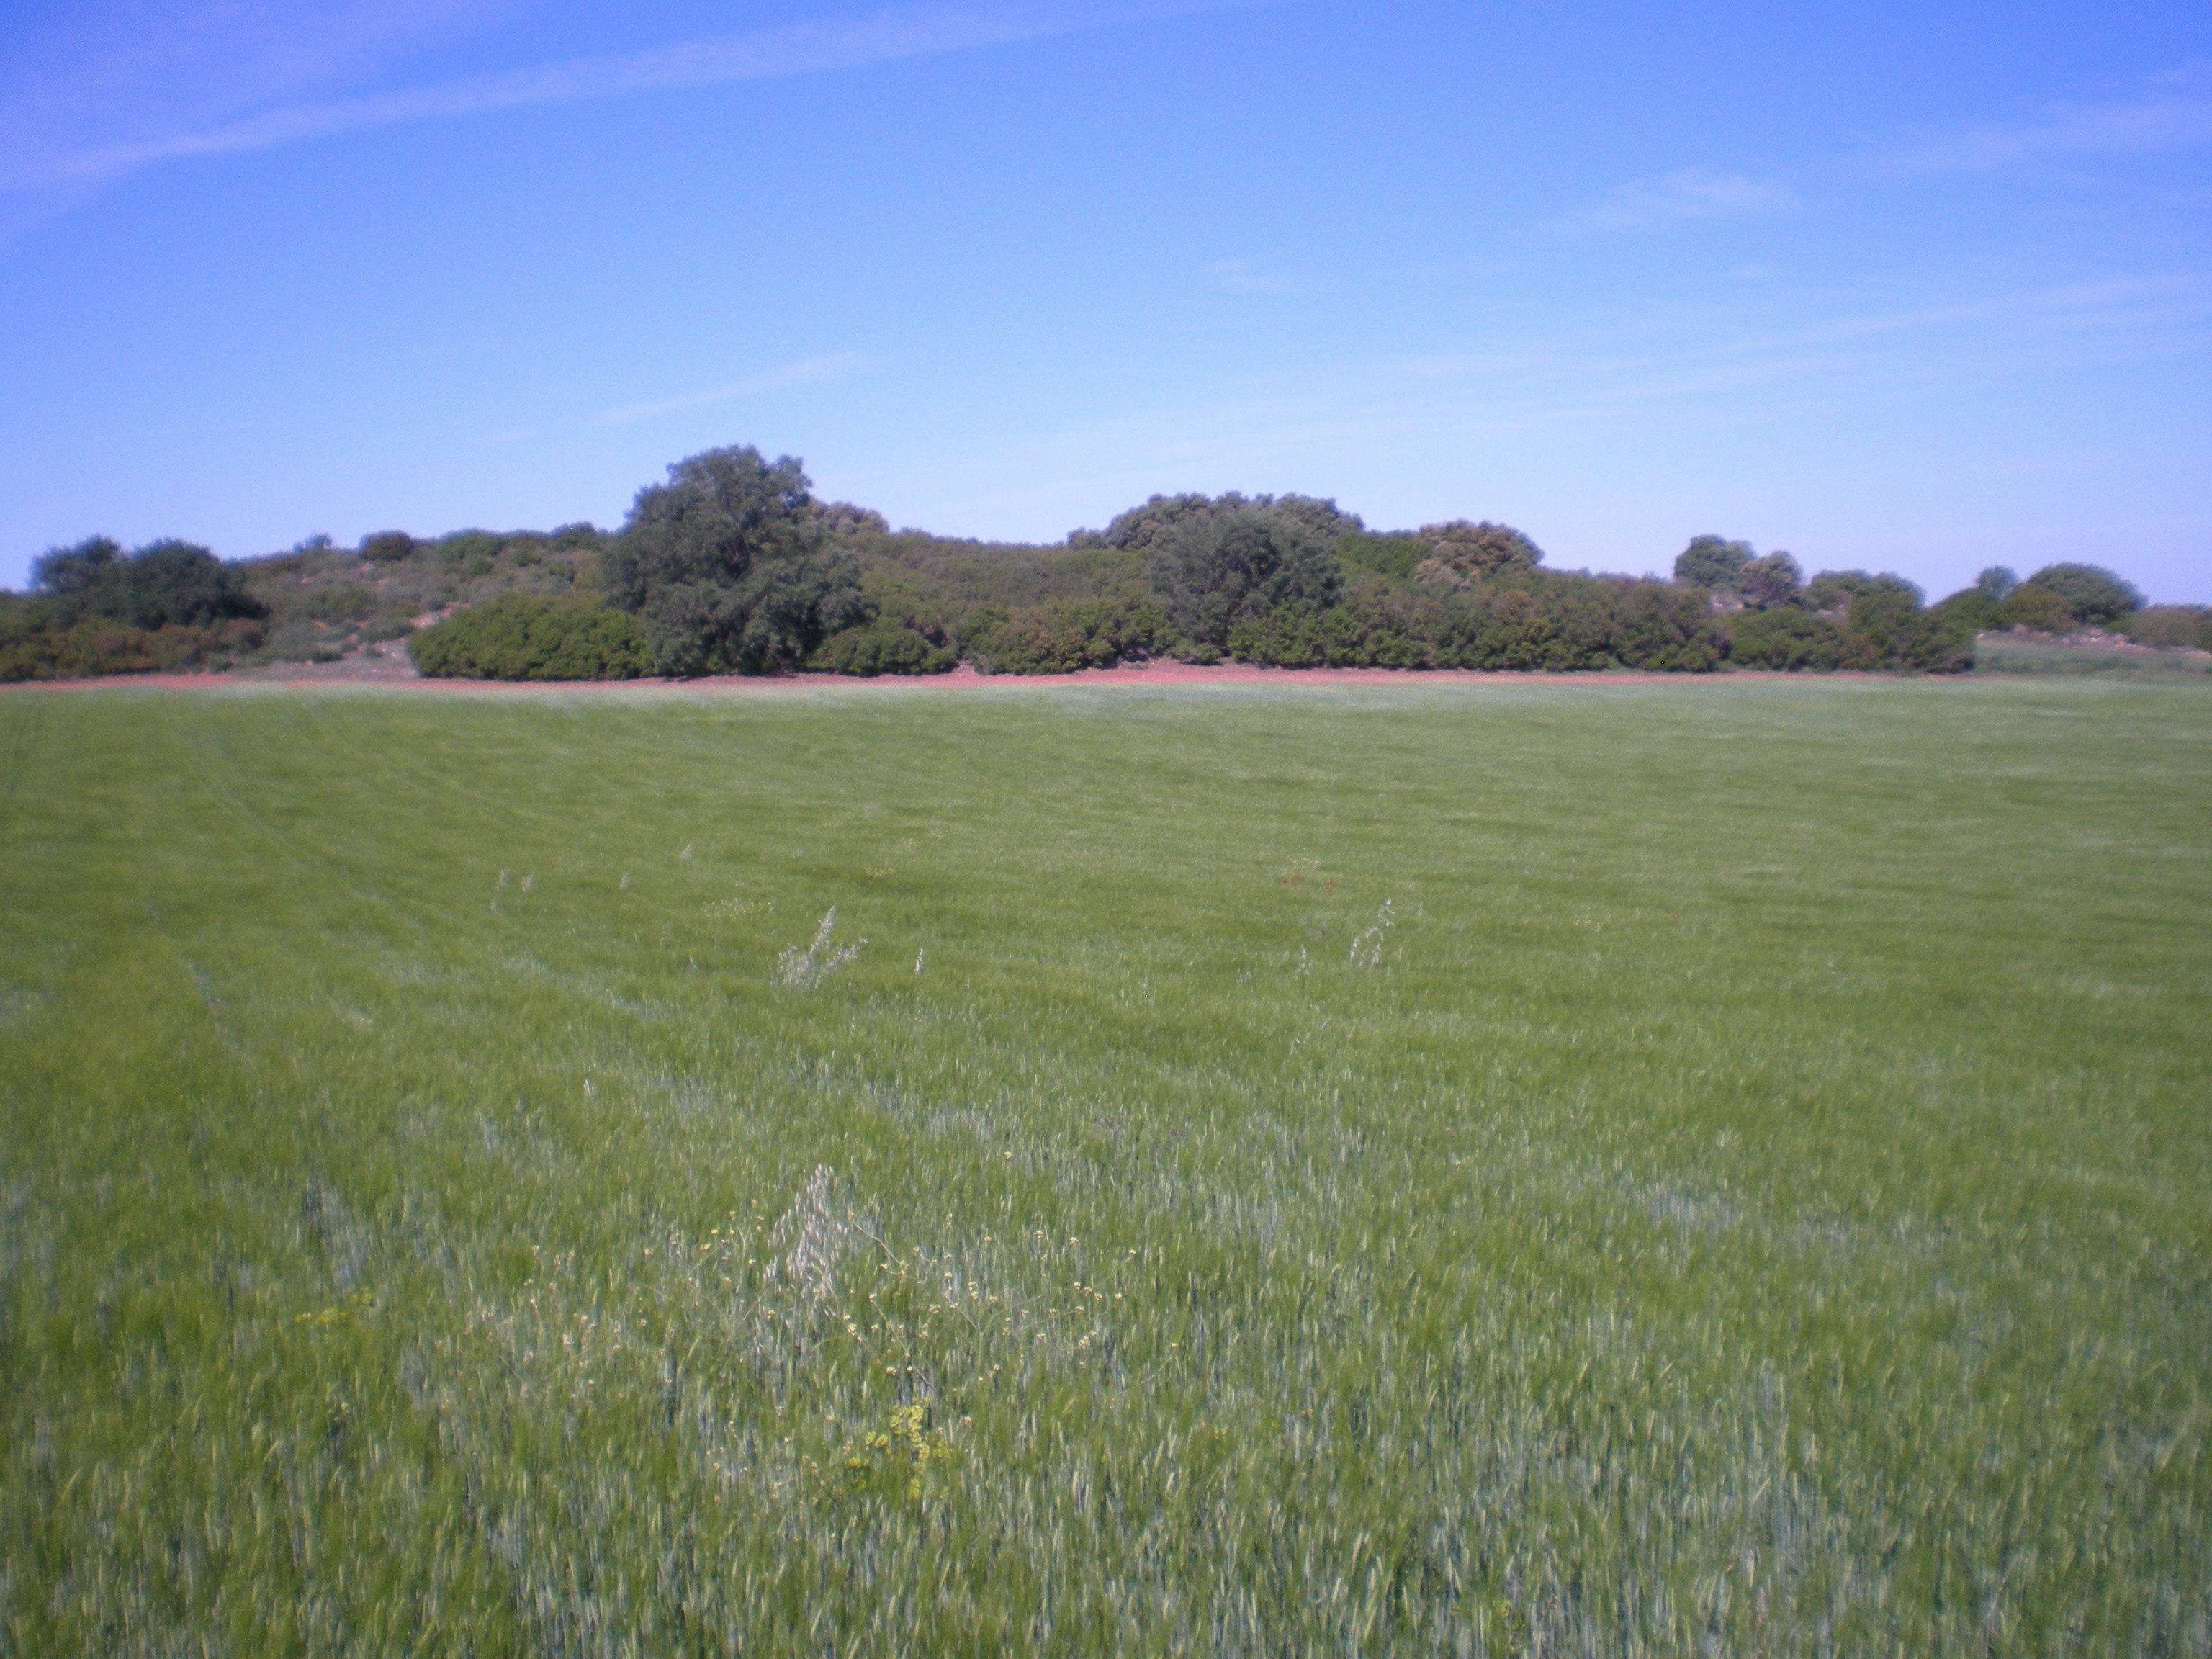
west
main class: Cropland
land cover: Barley
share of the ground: > 75 %
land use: Agriculture (excluding fallow land and kitchen gardens)
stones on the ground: 10 - 25 %
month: May
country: ES
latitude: 38.9360
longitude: -3.0343
